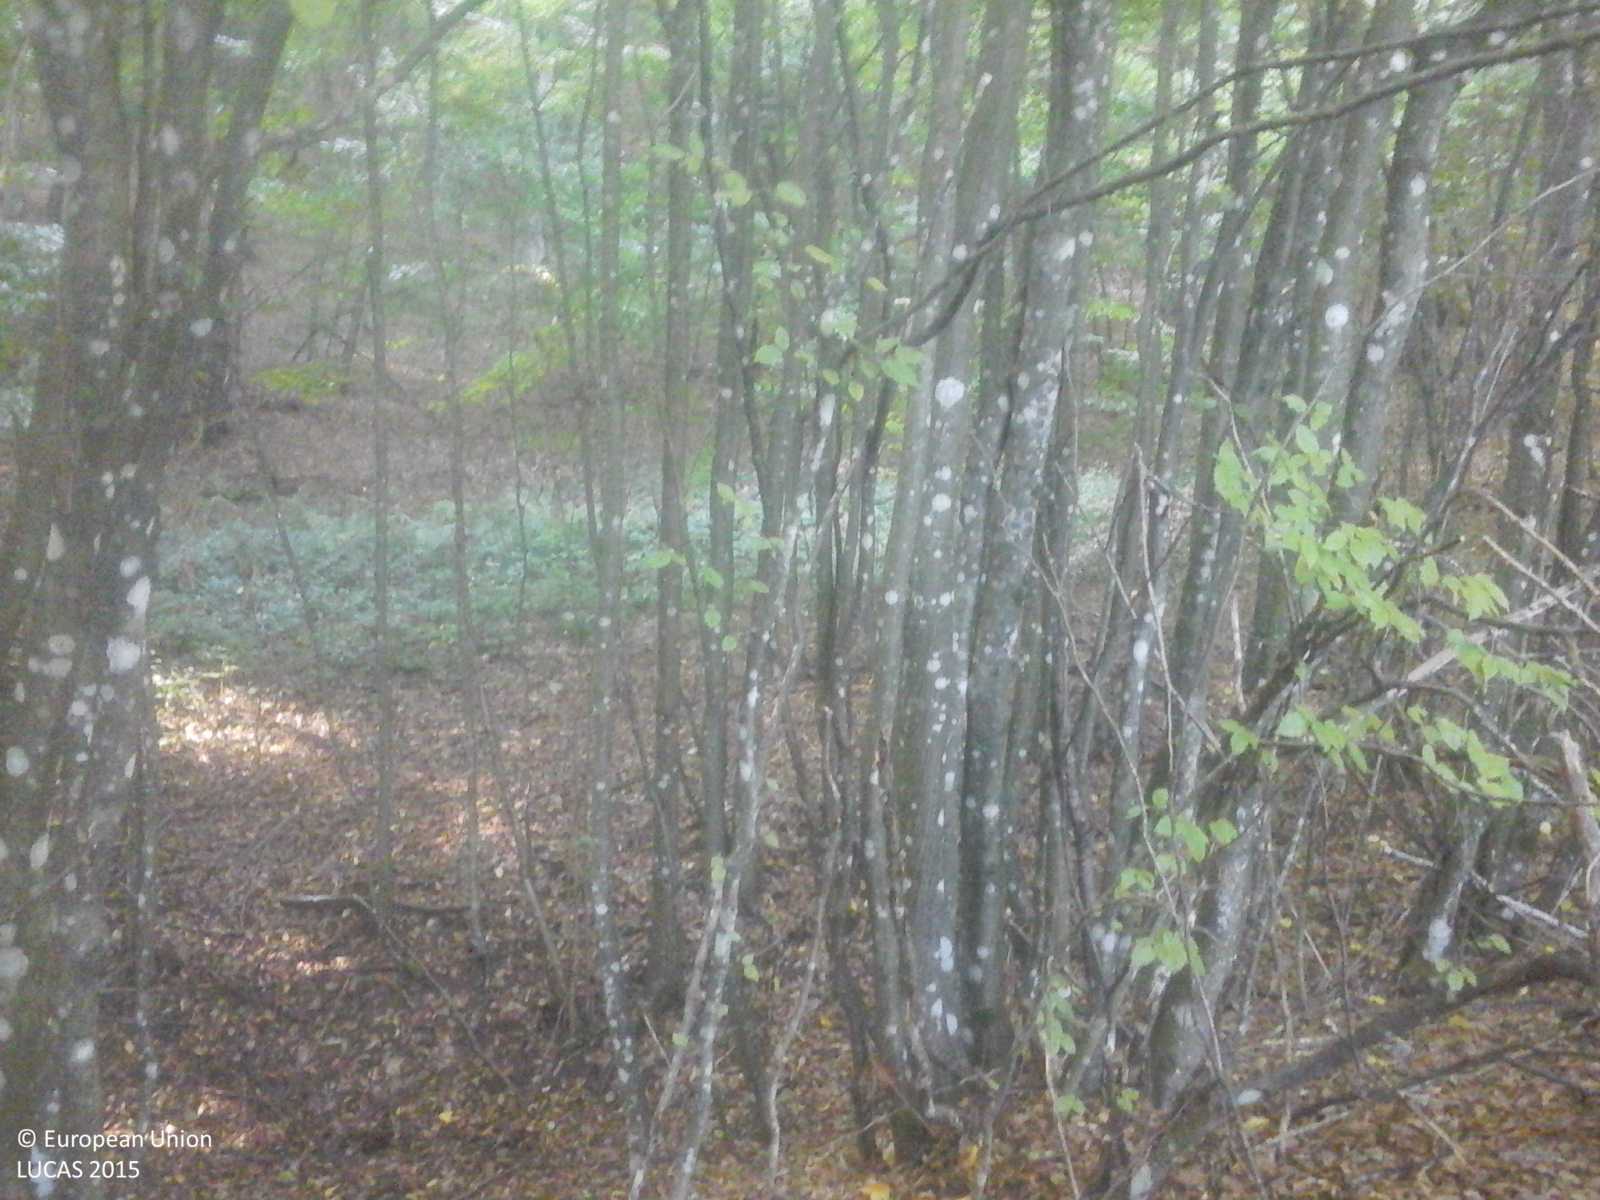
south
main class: Woodland
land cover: Broadleaved woodland
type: mesophytic deciduous forest
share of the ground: > 75 %
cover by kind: broadleaved forest trees 100 %
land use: Forestry
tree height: > 5 m
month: September
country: RO
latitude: 46.7854
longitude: 22.4571
